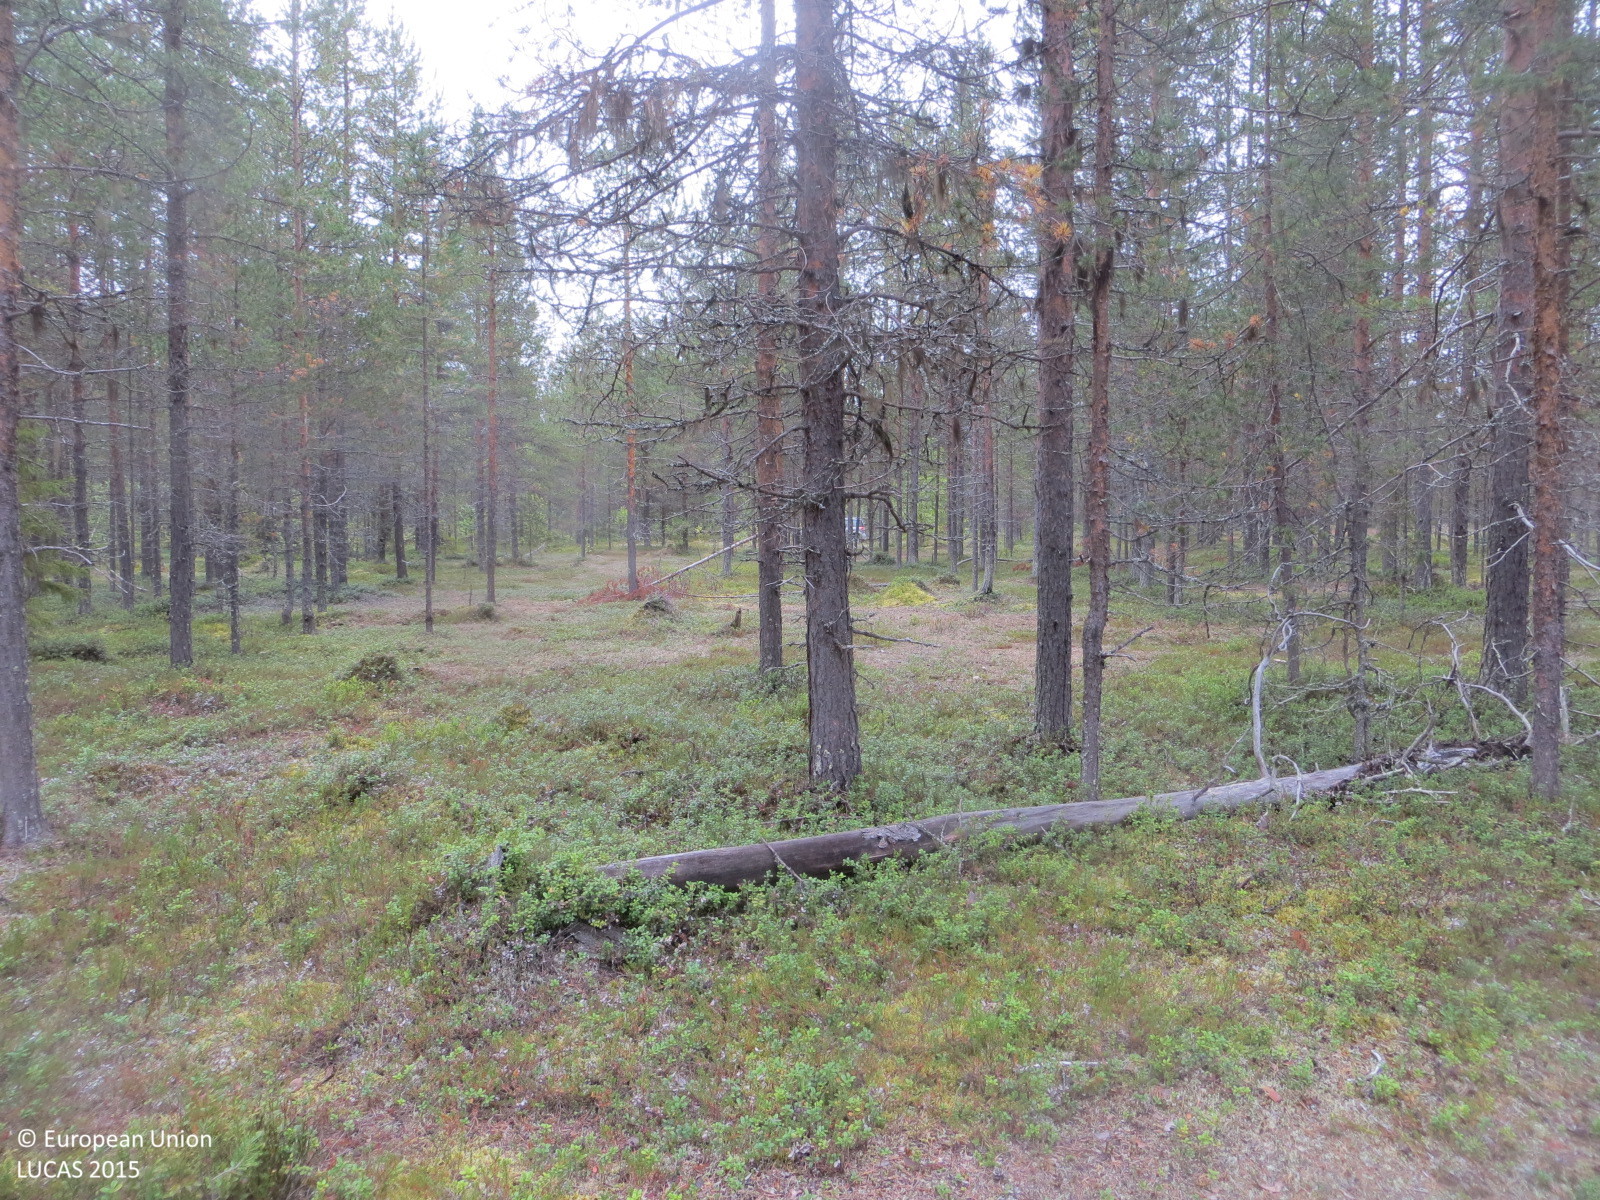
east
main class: Woodland
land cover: Pine dominated coniferous woodland
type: boreal forest
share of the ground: 50 - 75 %
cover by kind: coniferous forest trees 50 %, shrubs 50 %
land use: Forestry
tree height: > 5 m
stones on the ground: > 50 %
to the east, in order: Pine dominated coniferous woodland; Tracks; Abandoned hedges; Ditches and canals; Pine dominated coniferous woodland; Pine dominated mixed woodland; Ditches and canals; Pine dominated mixed woodland
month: August
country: FI
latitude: 67.4132
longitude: 24.1416
